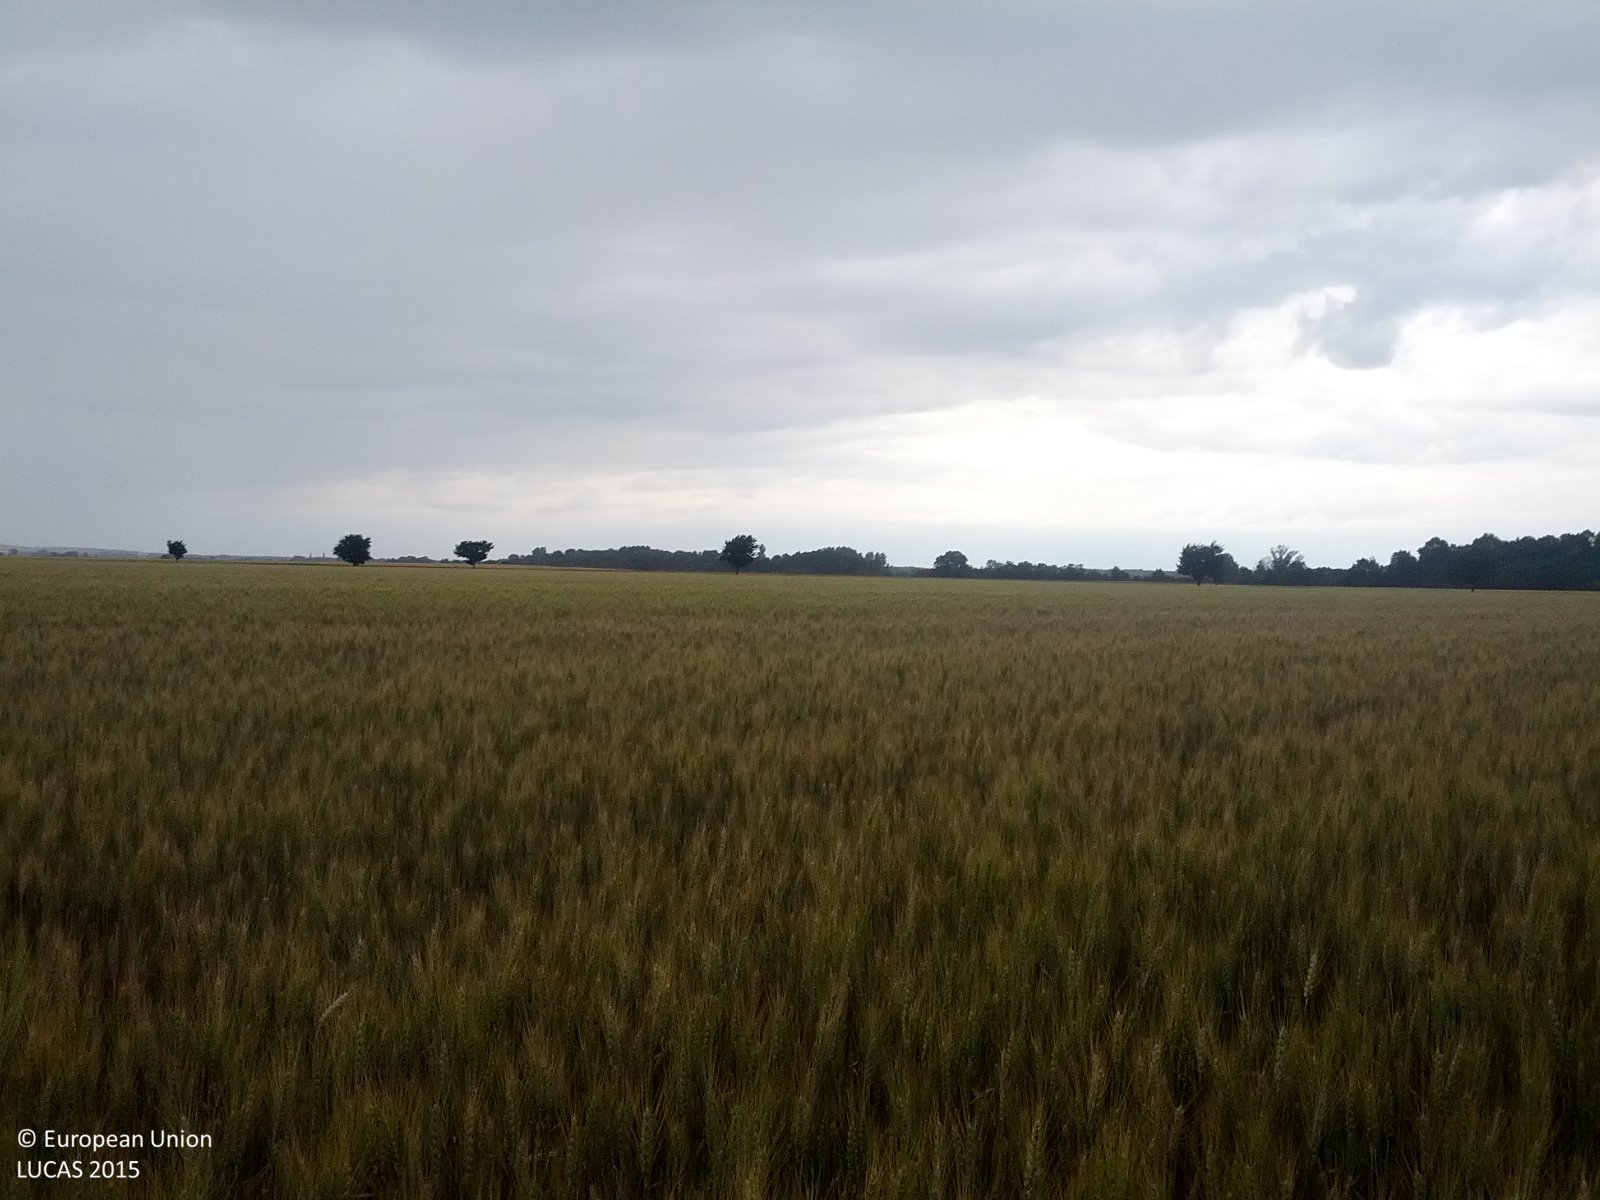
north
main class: Cropland
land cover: Common wheat
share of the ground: > 75 %
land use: Agriculture (excluding fallow land and kitchen gardens)
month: June
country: AT
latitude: 48.2803
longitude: 16.8662
